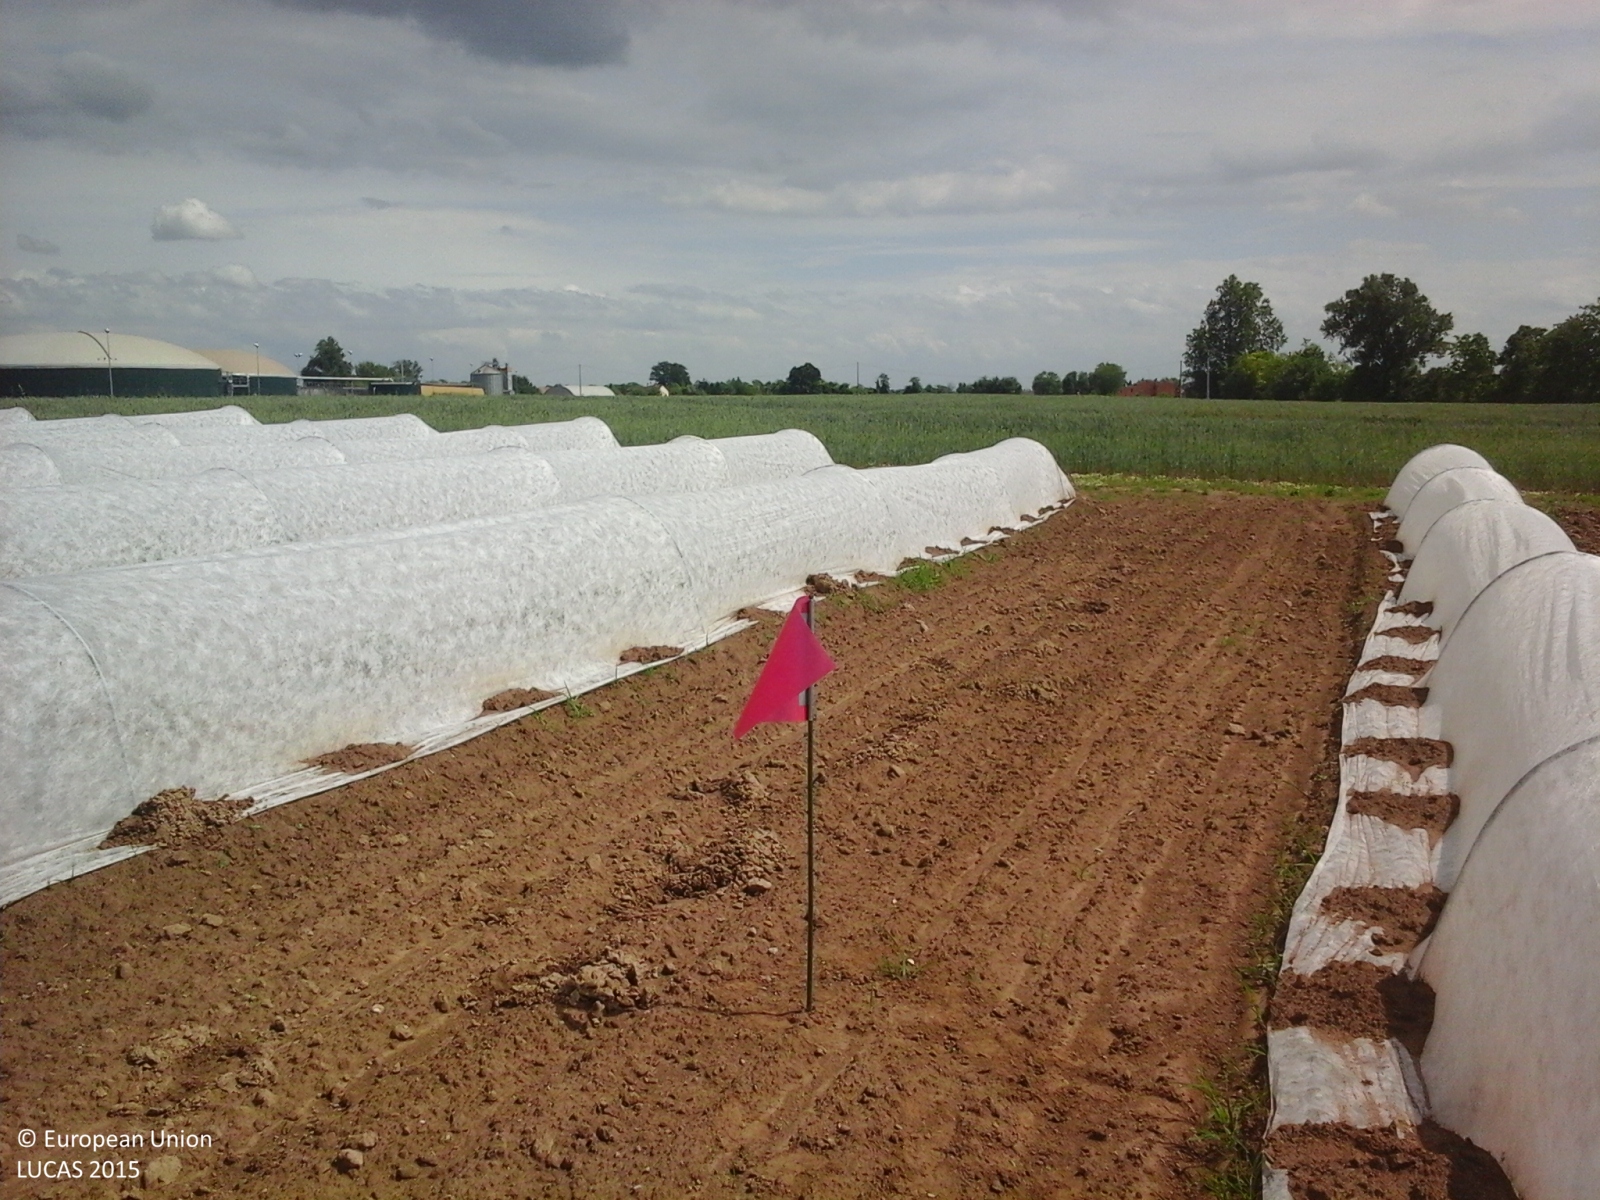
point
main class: Cropland
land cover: Other fresh vegetables
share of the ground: < 10 %
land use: Agriculture (excluding fallow land and kitchen gardens)
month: May
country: IT
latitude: 45.0875
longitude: 10.6974
